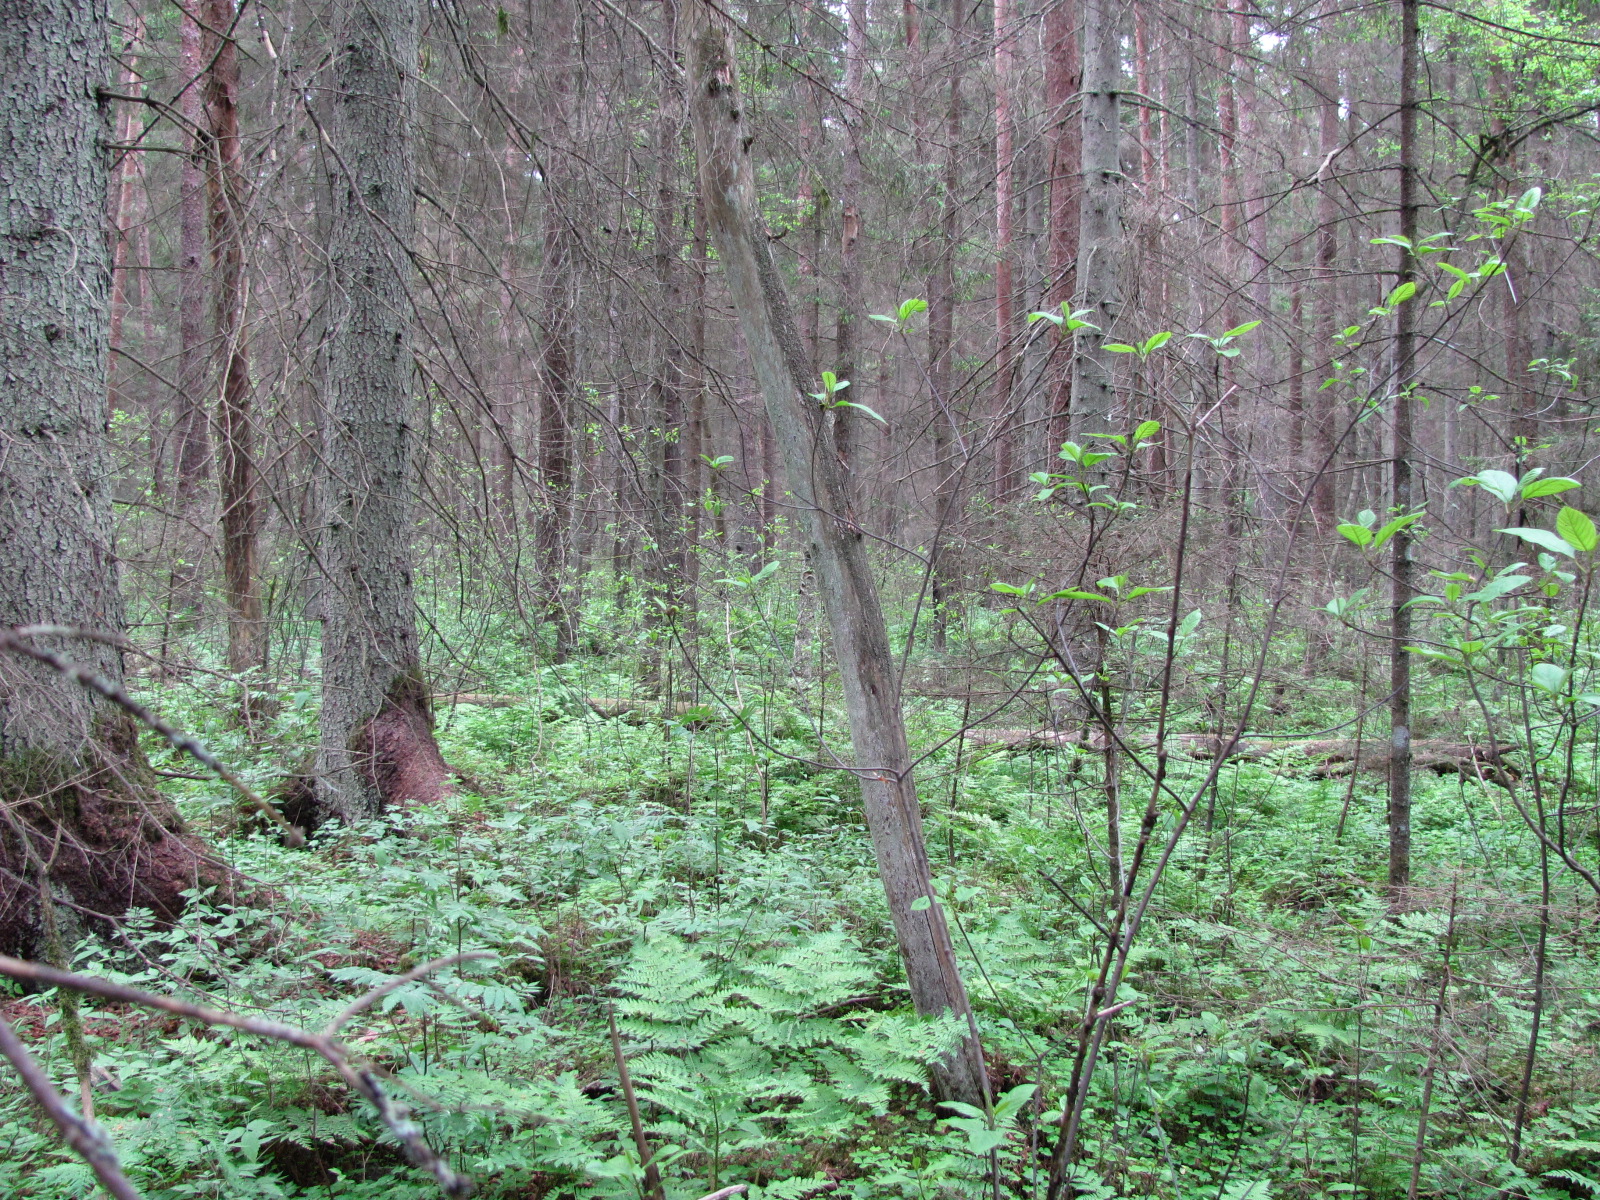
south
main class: Woodland
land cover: Other coniferous woodland
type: hemiboreal forest and nemoral coniferous forest and mixed broadleaved-coniferous forest
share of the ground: > 75 %
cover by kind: coniferous forest trees 100 %
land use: Forestry
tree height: > 5 m
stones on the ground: < 10 %
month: June
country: LV
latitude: 56.8271
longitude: 24.1298
